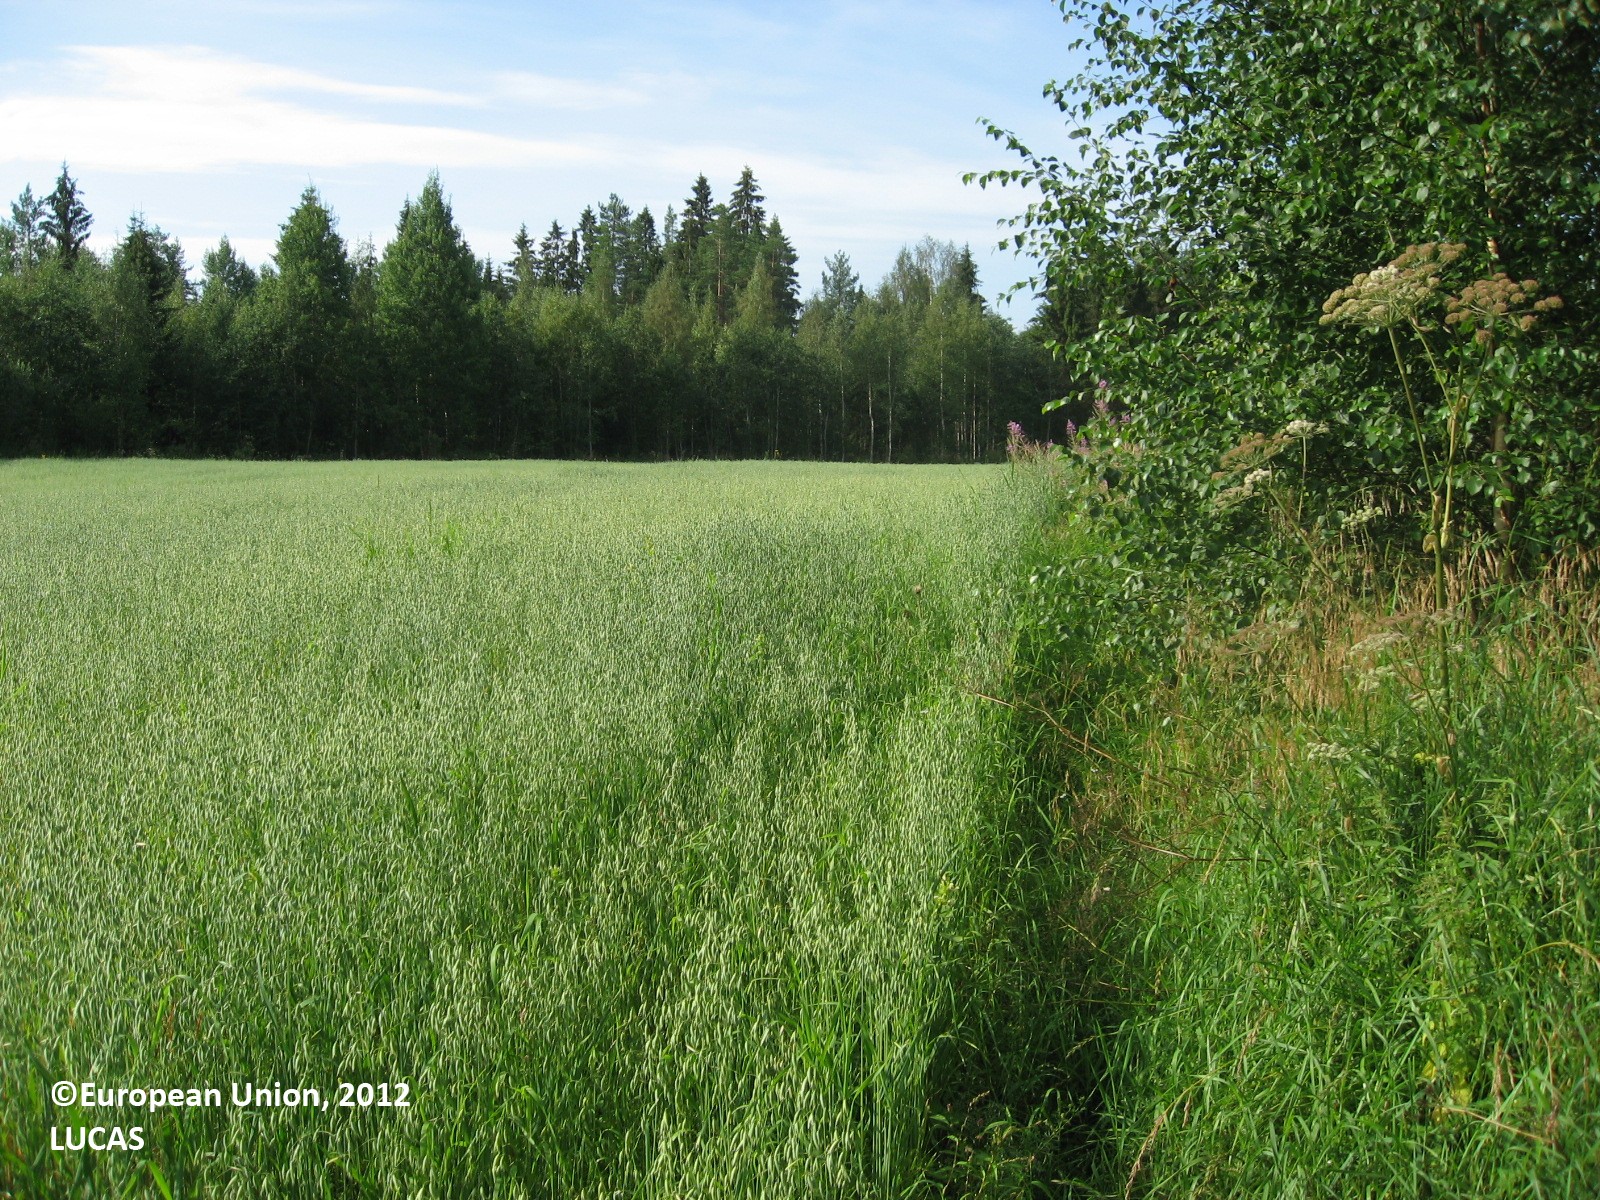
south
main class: Cropland
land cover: Oats
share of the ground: > 75 %
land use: Agriculture (excluding fallow land and kitchen gardens)
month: August
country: FI
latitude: 61.5147
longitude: 25.9392
